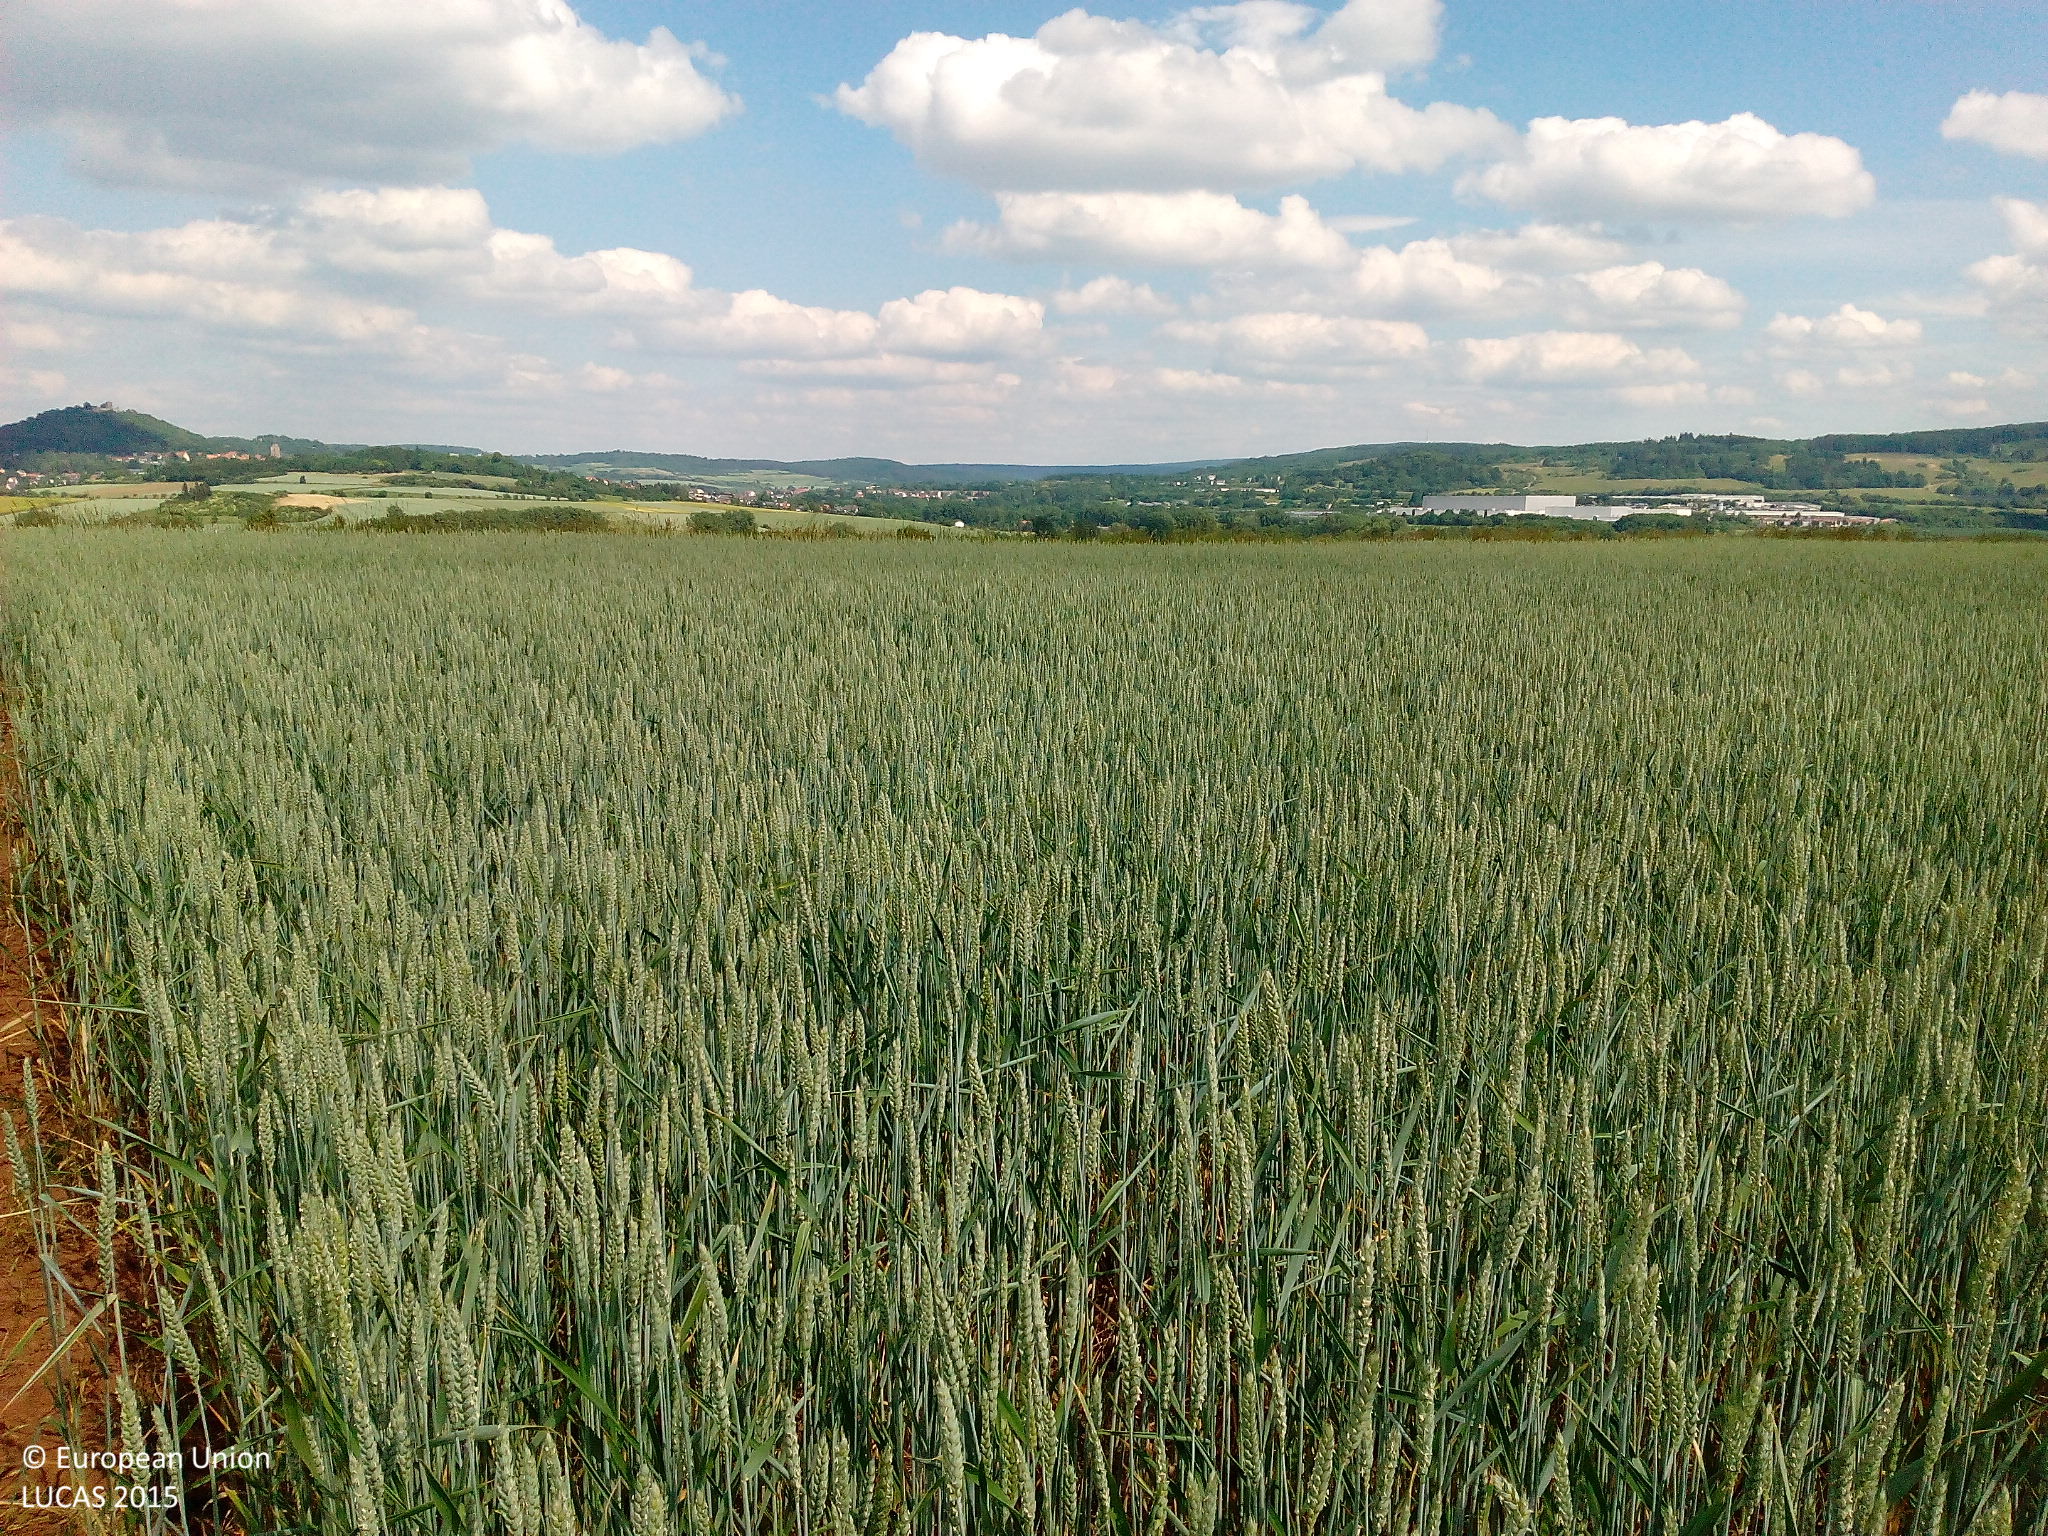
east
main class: Cropland
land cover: Common wheat
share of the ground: > 75 %
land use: Agriculture (excluding fallow land and kitchen gardens)
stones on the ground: < 10 %
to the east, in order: Common wheat; Grass margins; Tracks; Grass margins; Other fresh vegetables; Grass margins; Ditches and canals; Grass margins; Paved roads, cycling and walking lanes; Grass margins; Ditches and canals; Grass margins; Common wheat
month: June
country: DE
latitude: 51.0275
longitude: 9.3586
